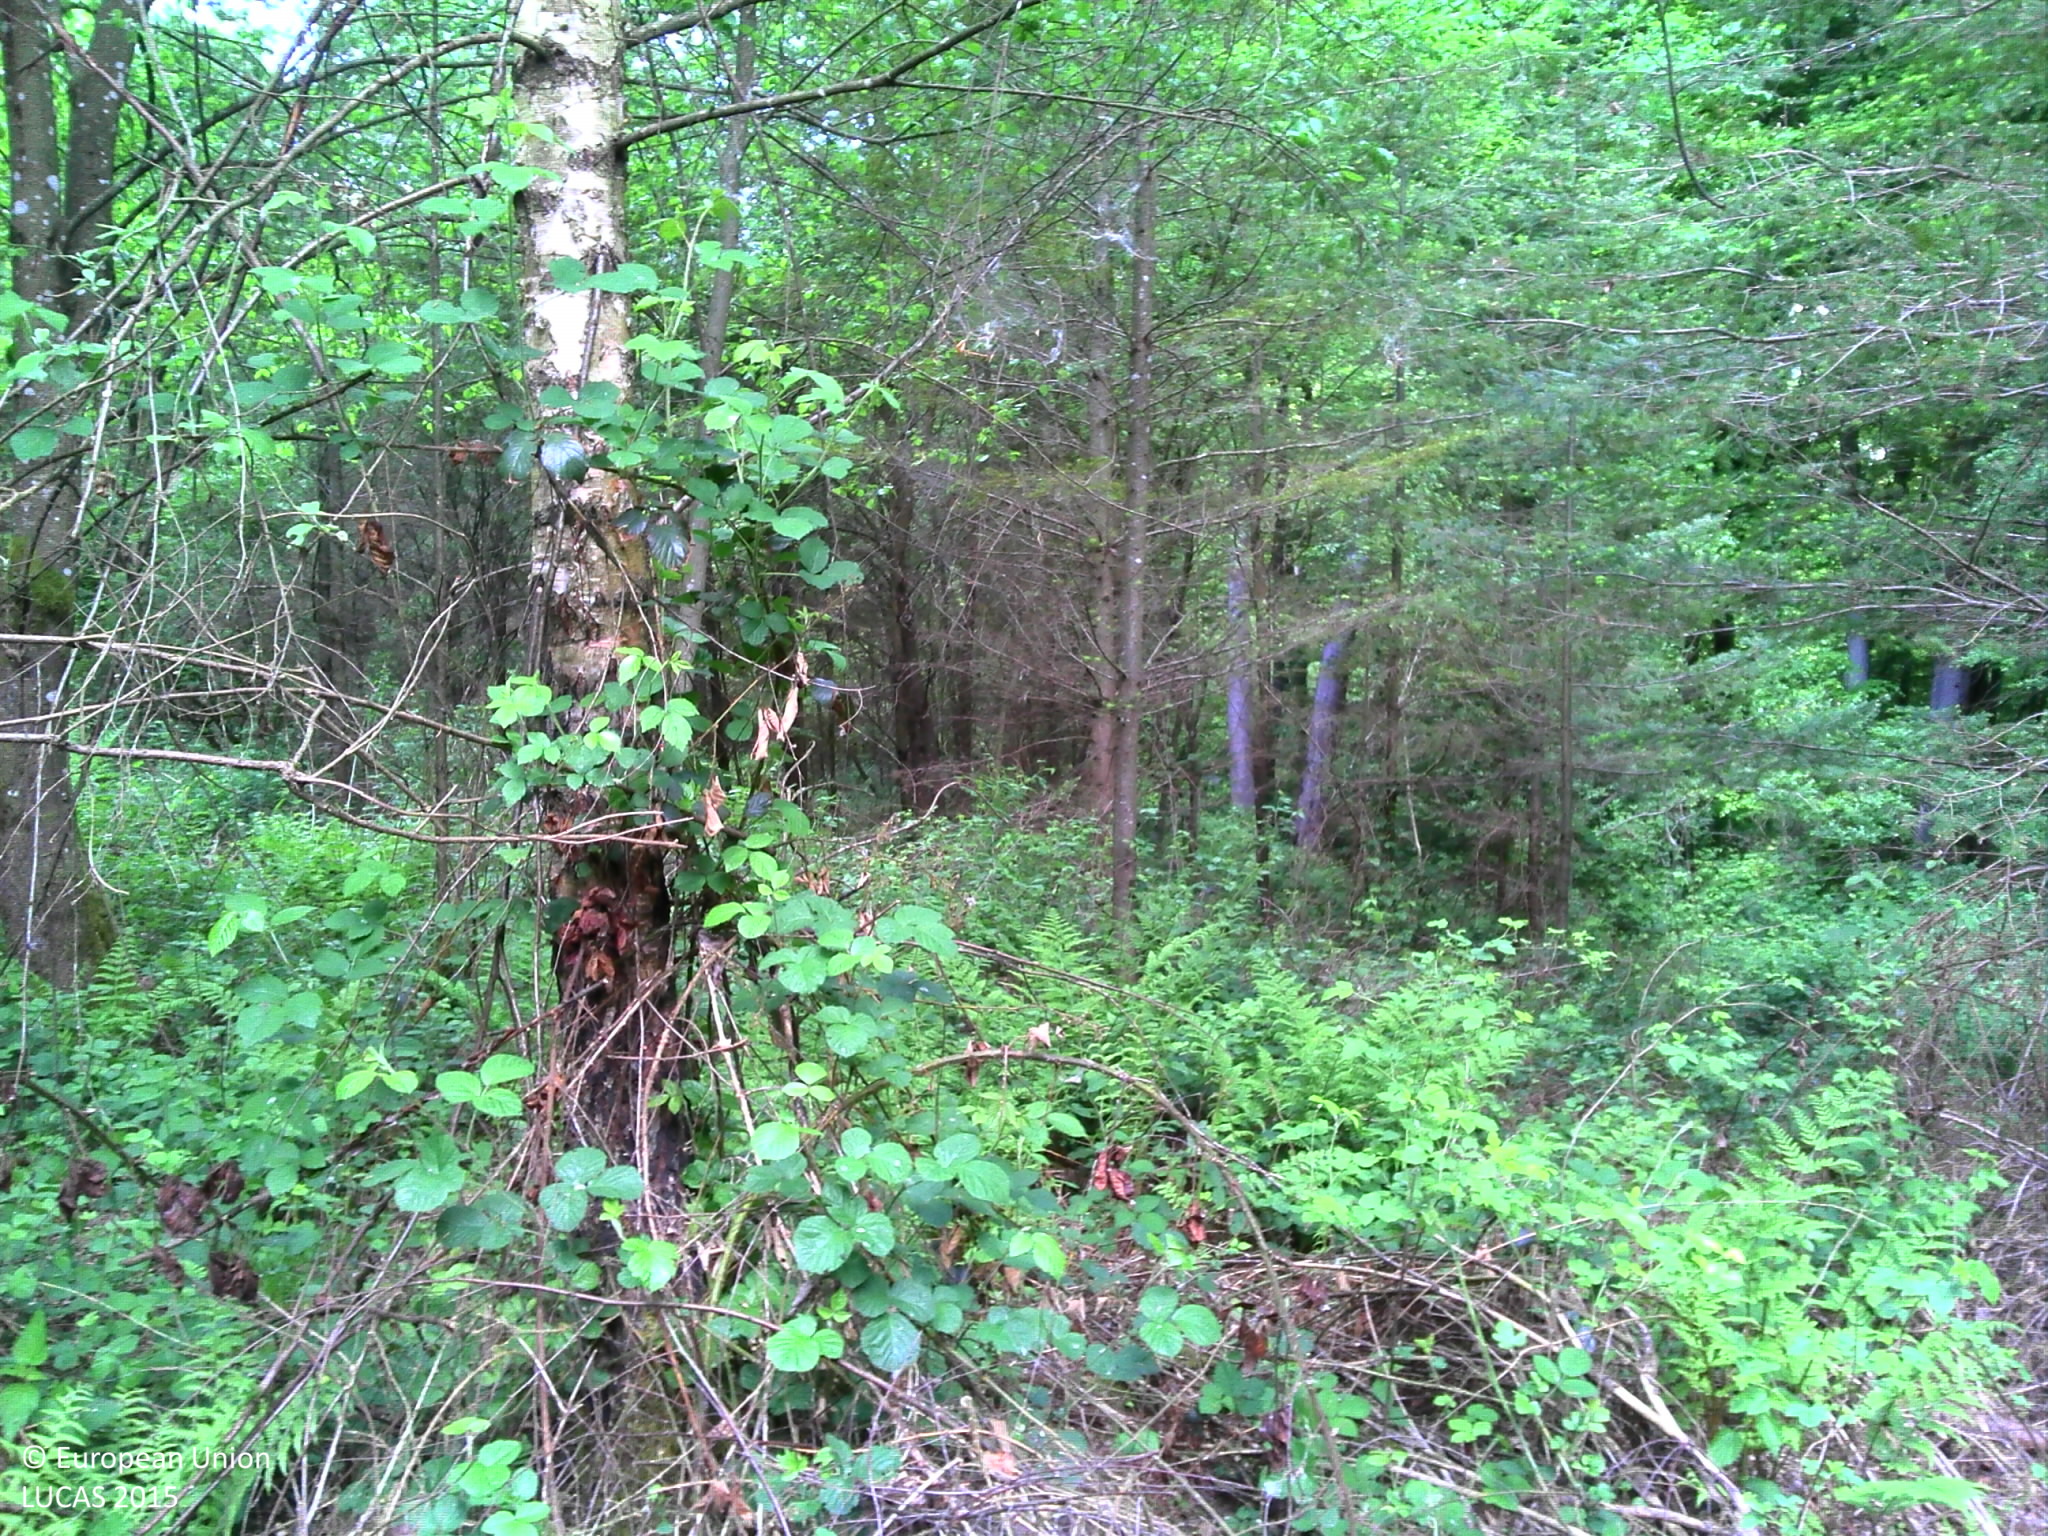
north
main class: Woodland
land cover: Other mixed woodland
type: hemiboreal forest and nemoral coniferous forest and mixed broadleaved-coniferous forest
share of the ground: > 75 %
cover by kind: broadleaved forest trees 60 %, coniferous forest trees 40 %
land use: Forestry
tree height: > 5 m
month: May
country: LU
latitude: 49.6827
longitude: 6.0215
